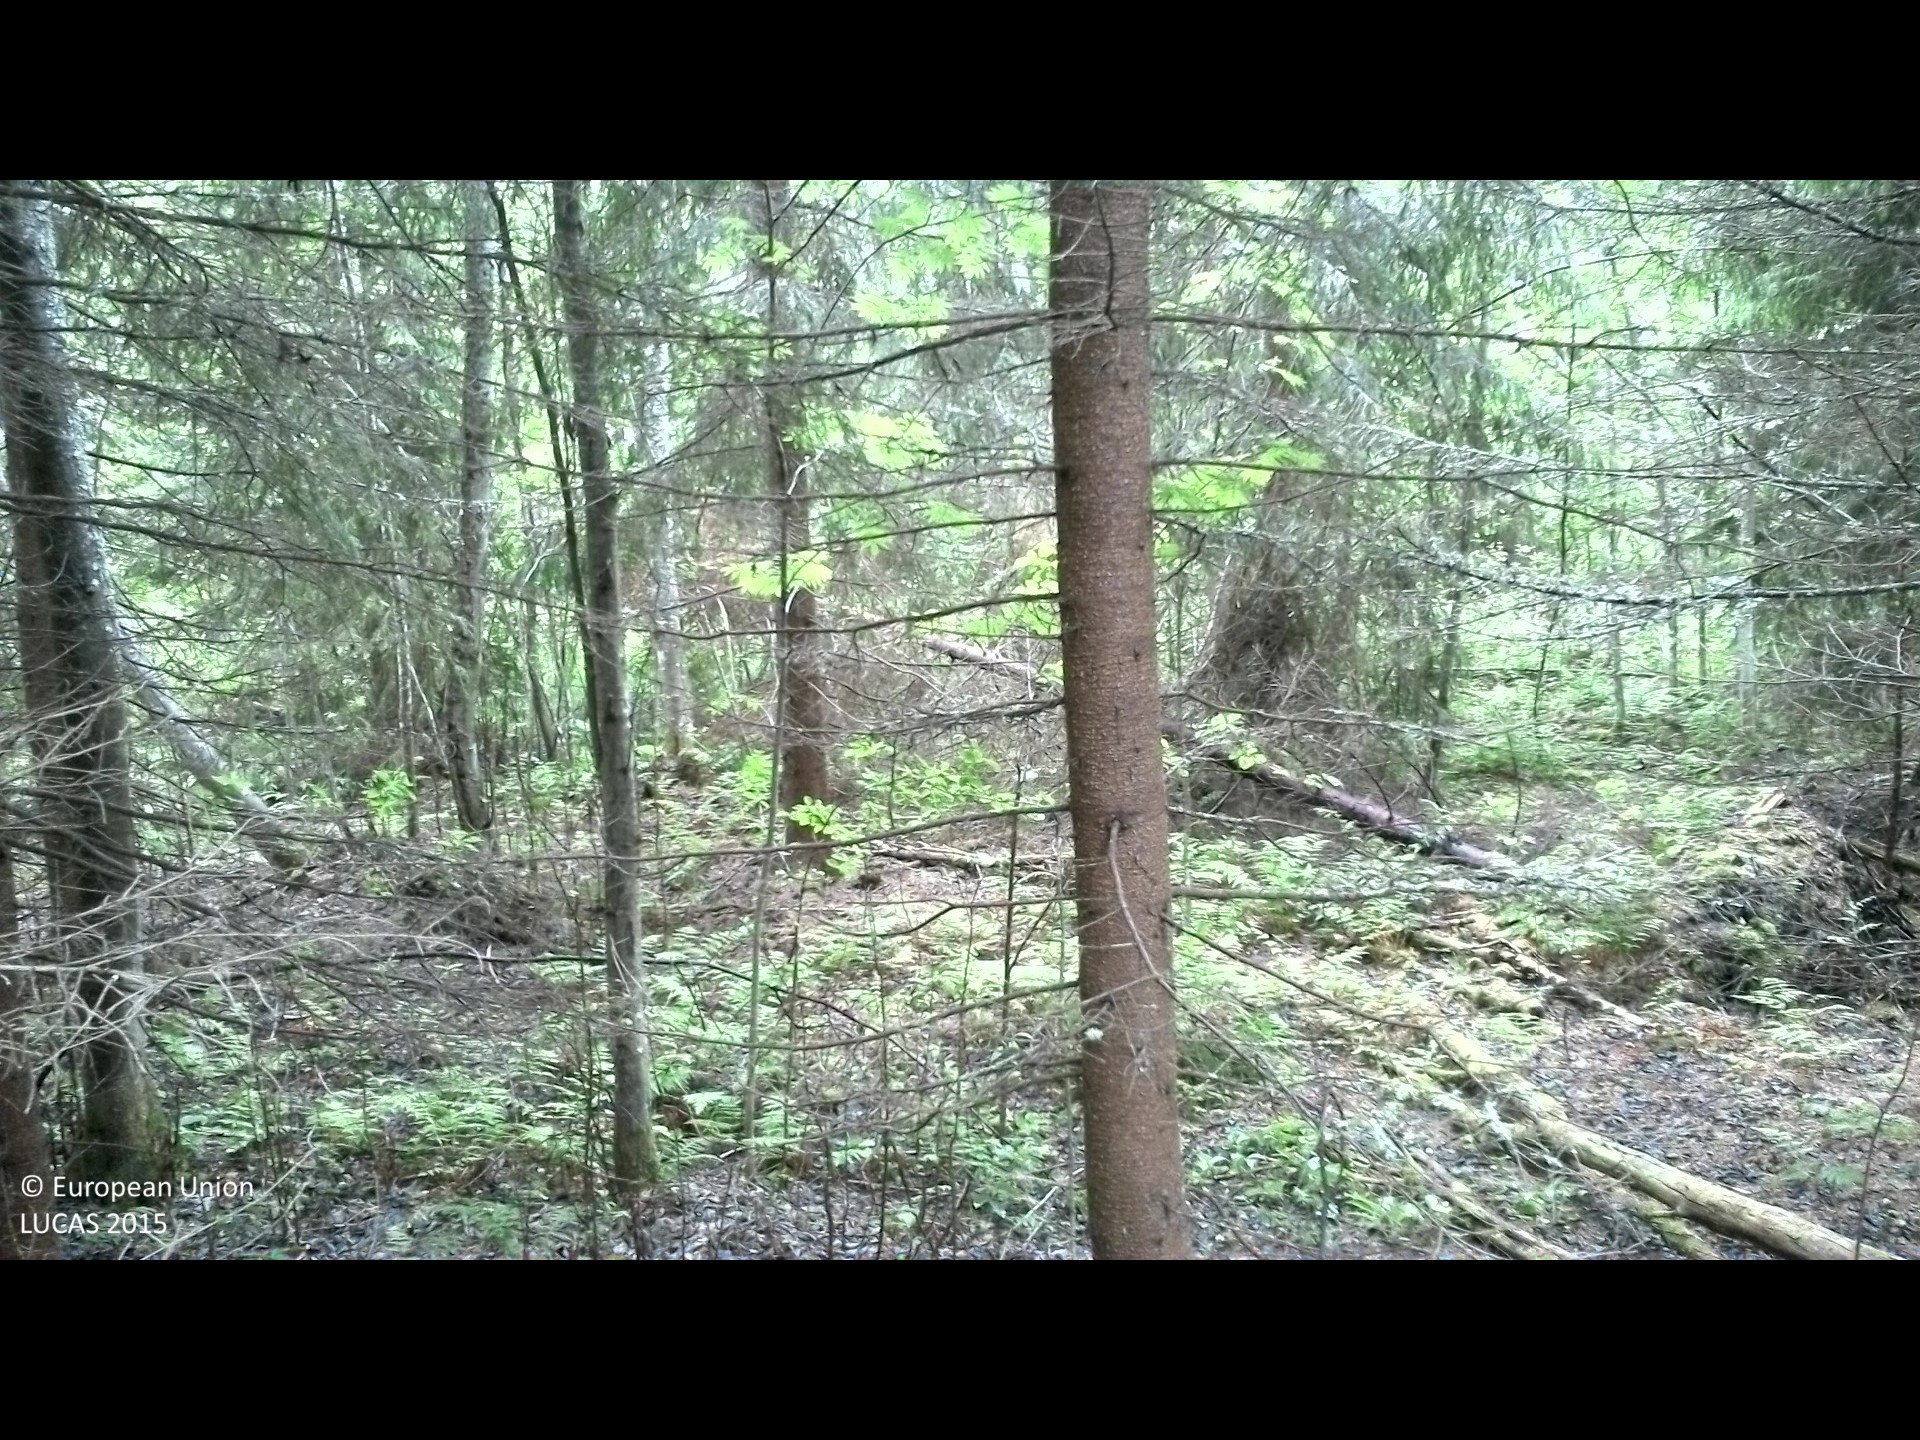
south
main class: Woodland
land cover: Spruce dominated coniferous woodland
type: boreal forest
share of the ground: 50 - 75 %
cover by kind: coniferous forest trees 45 %, herbaceous plants 25 %, lichens and mosses 25 %, broadleaved forest trees 5 %
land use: Forestry
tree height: > 5 m
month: June
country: SE
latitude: 61.9562
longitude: 17.0943
